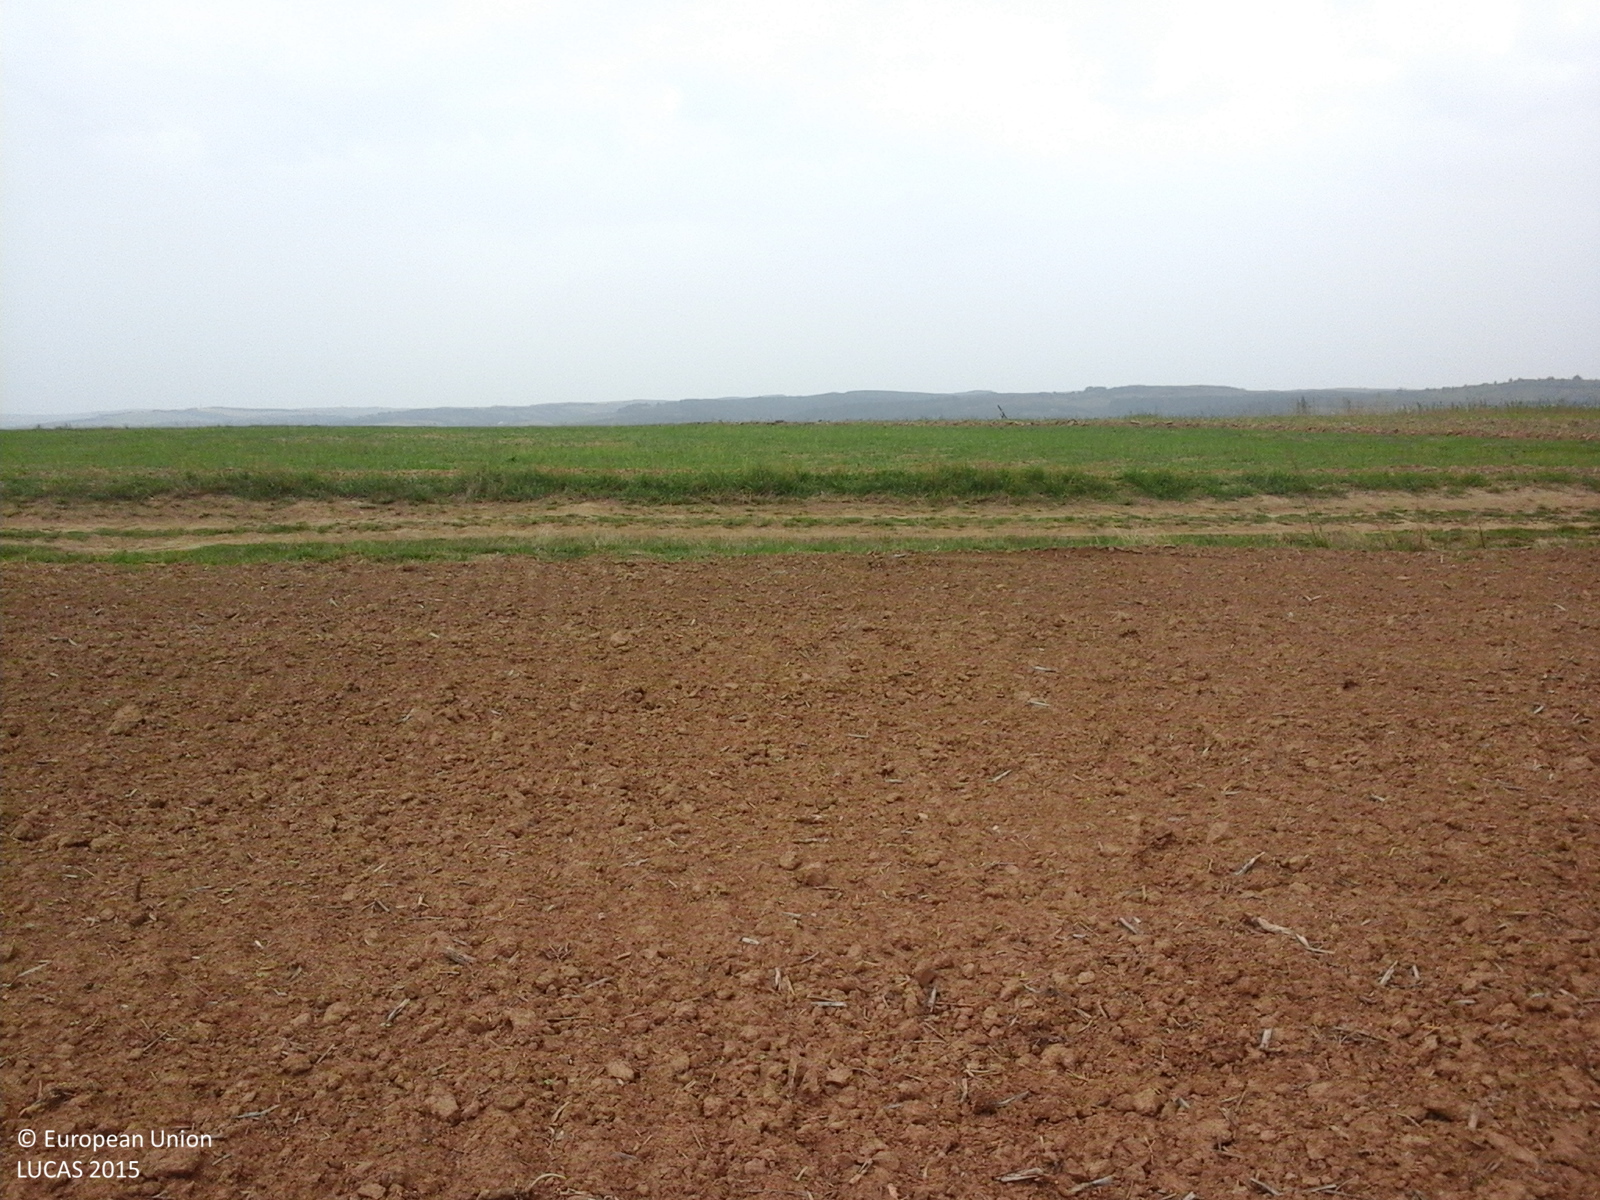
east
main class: Cropland
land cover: Rape and turnip rape
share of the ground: < 10 %
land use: Agriculture (excluding fallow land and kitchen gardens)
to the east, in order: Rape and turnip rape; Grass margins; Tracks; Grass margins; Grassland without tree/shrub cover; Other bare soil; Tracks; Other bare soil; Grass margins; Tracks; Grass margins; Other bare soil
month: September
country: RO
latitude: 47.3764
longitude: 22.3850
